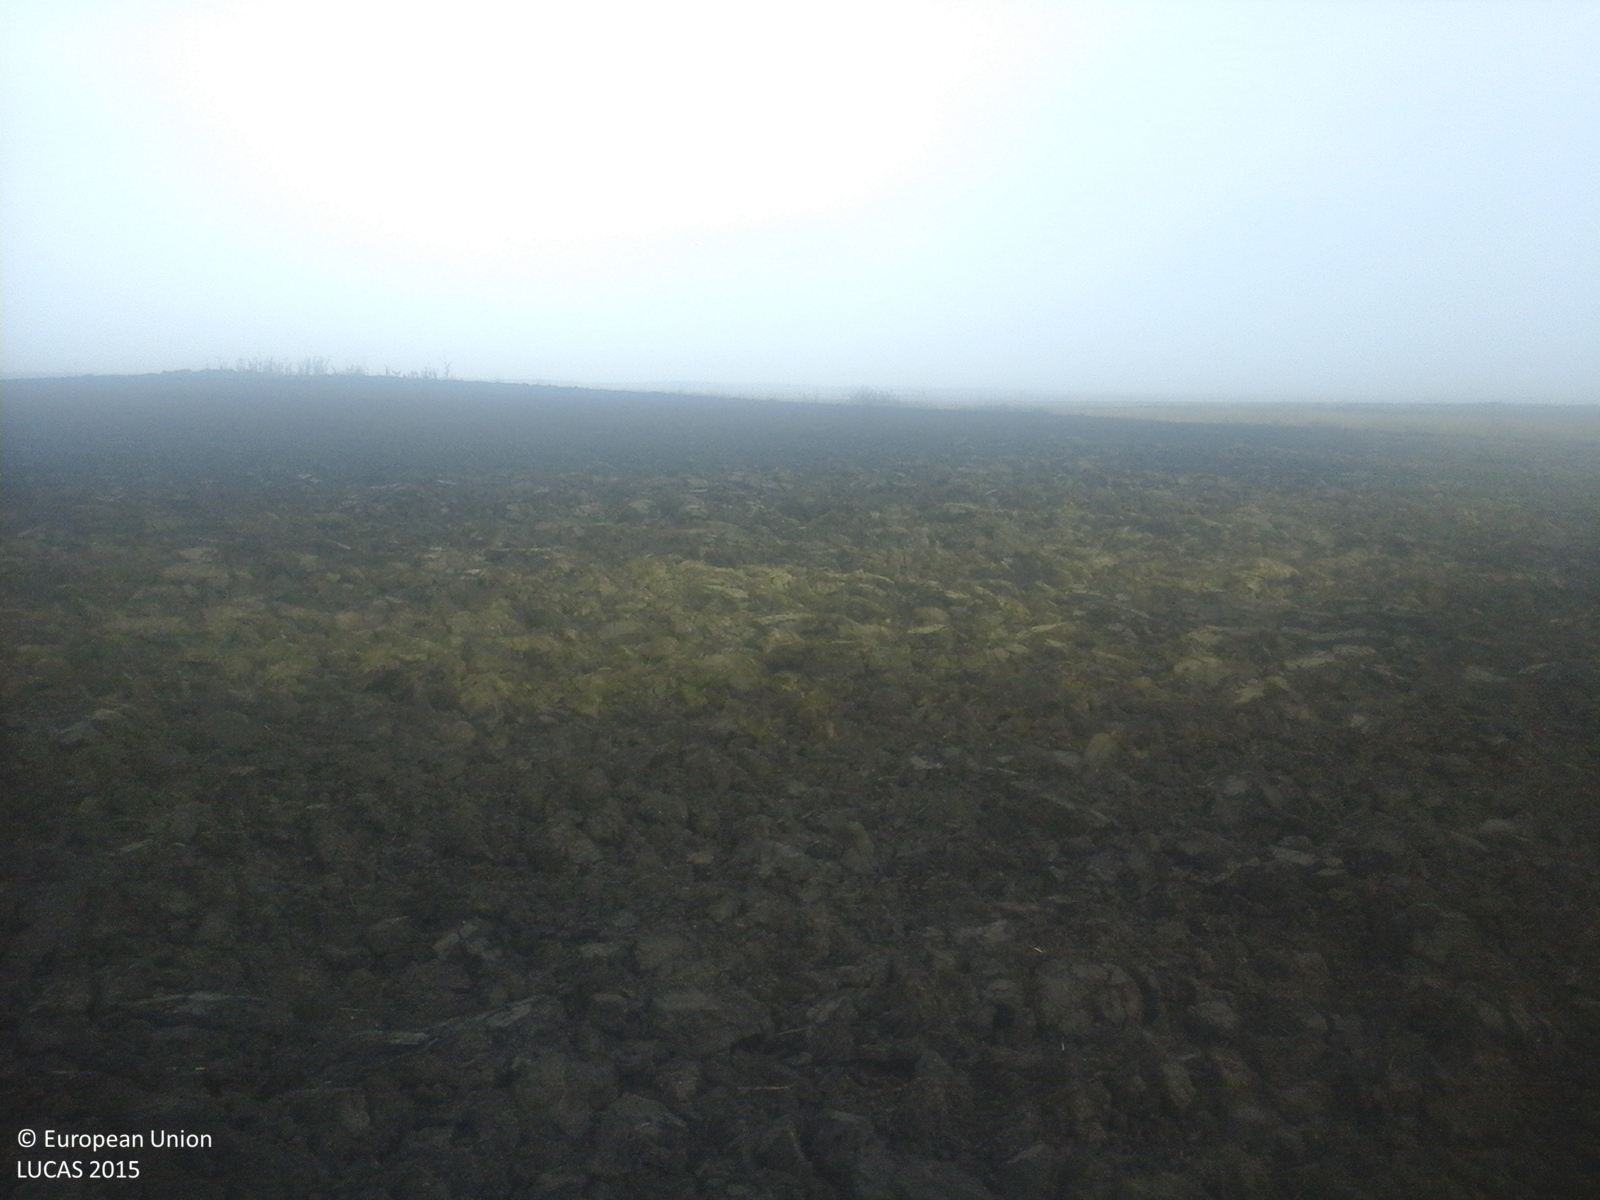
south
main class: Cropland
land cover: Rape and turnip rape
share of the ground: < 10 %
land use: Agriculture (excluding fallow land and kitchen gardens)
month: September
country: RO
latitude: 47.5358
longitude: 22.4236
